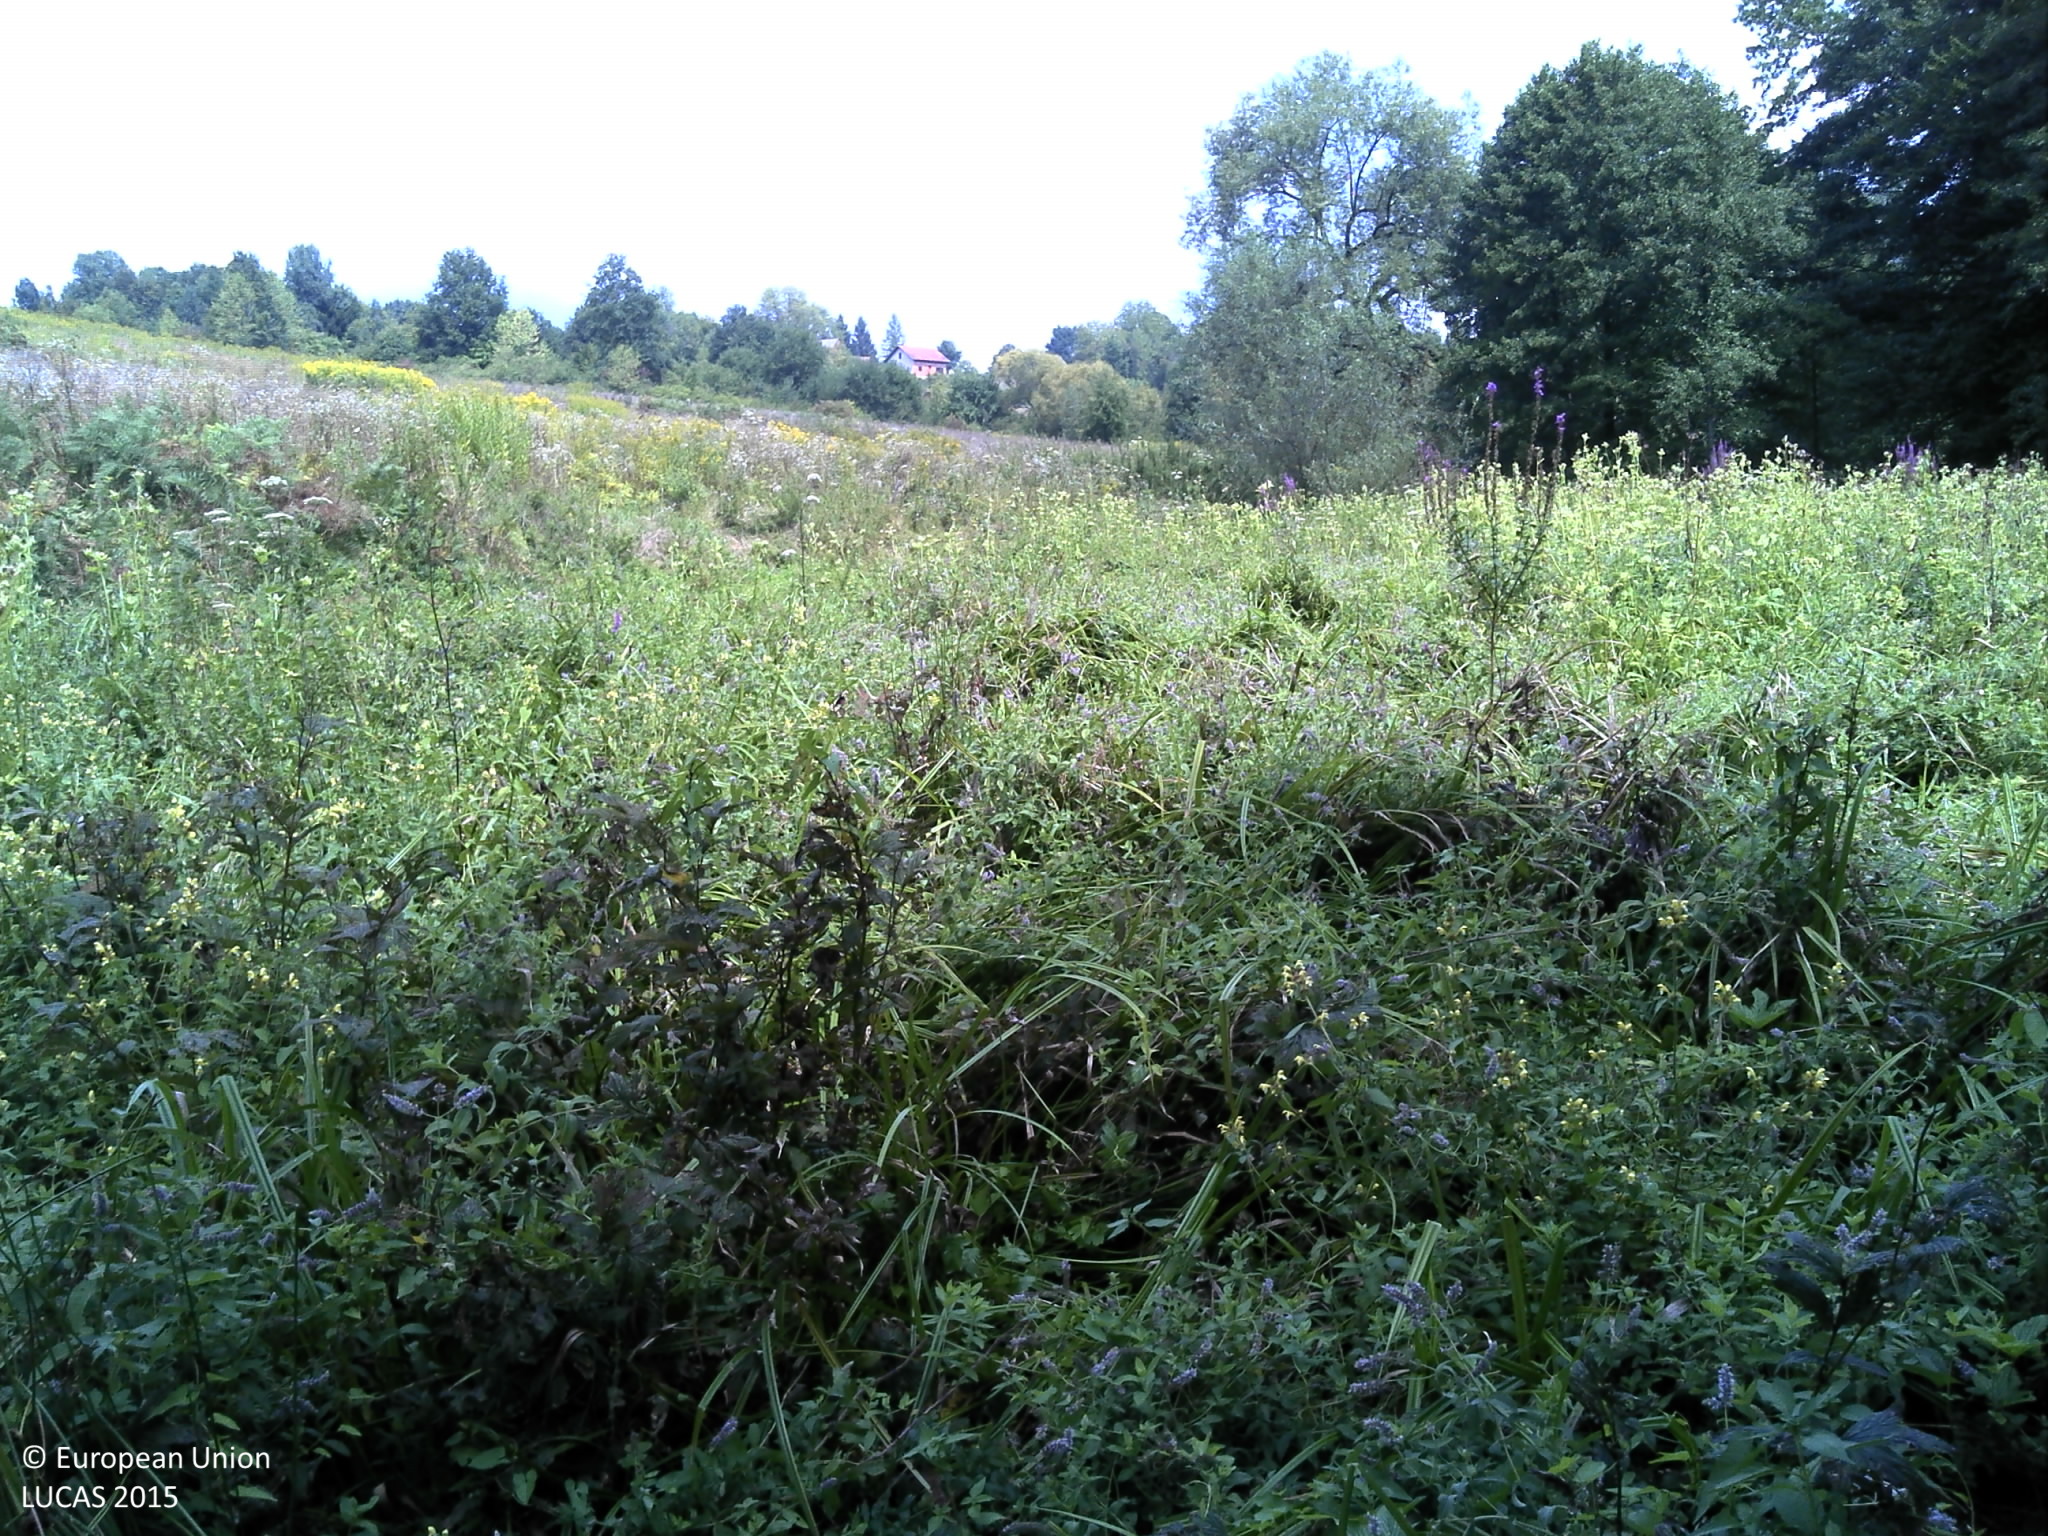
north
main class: Grassland
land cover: Spontaneously vegetated surfaces
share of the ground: > 75 %
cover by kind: herbaceous plants 100 %
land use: Fallow land
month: August
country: HR
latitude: 45.2931
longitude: 16.0788
